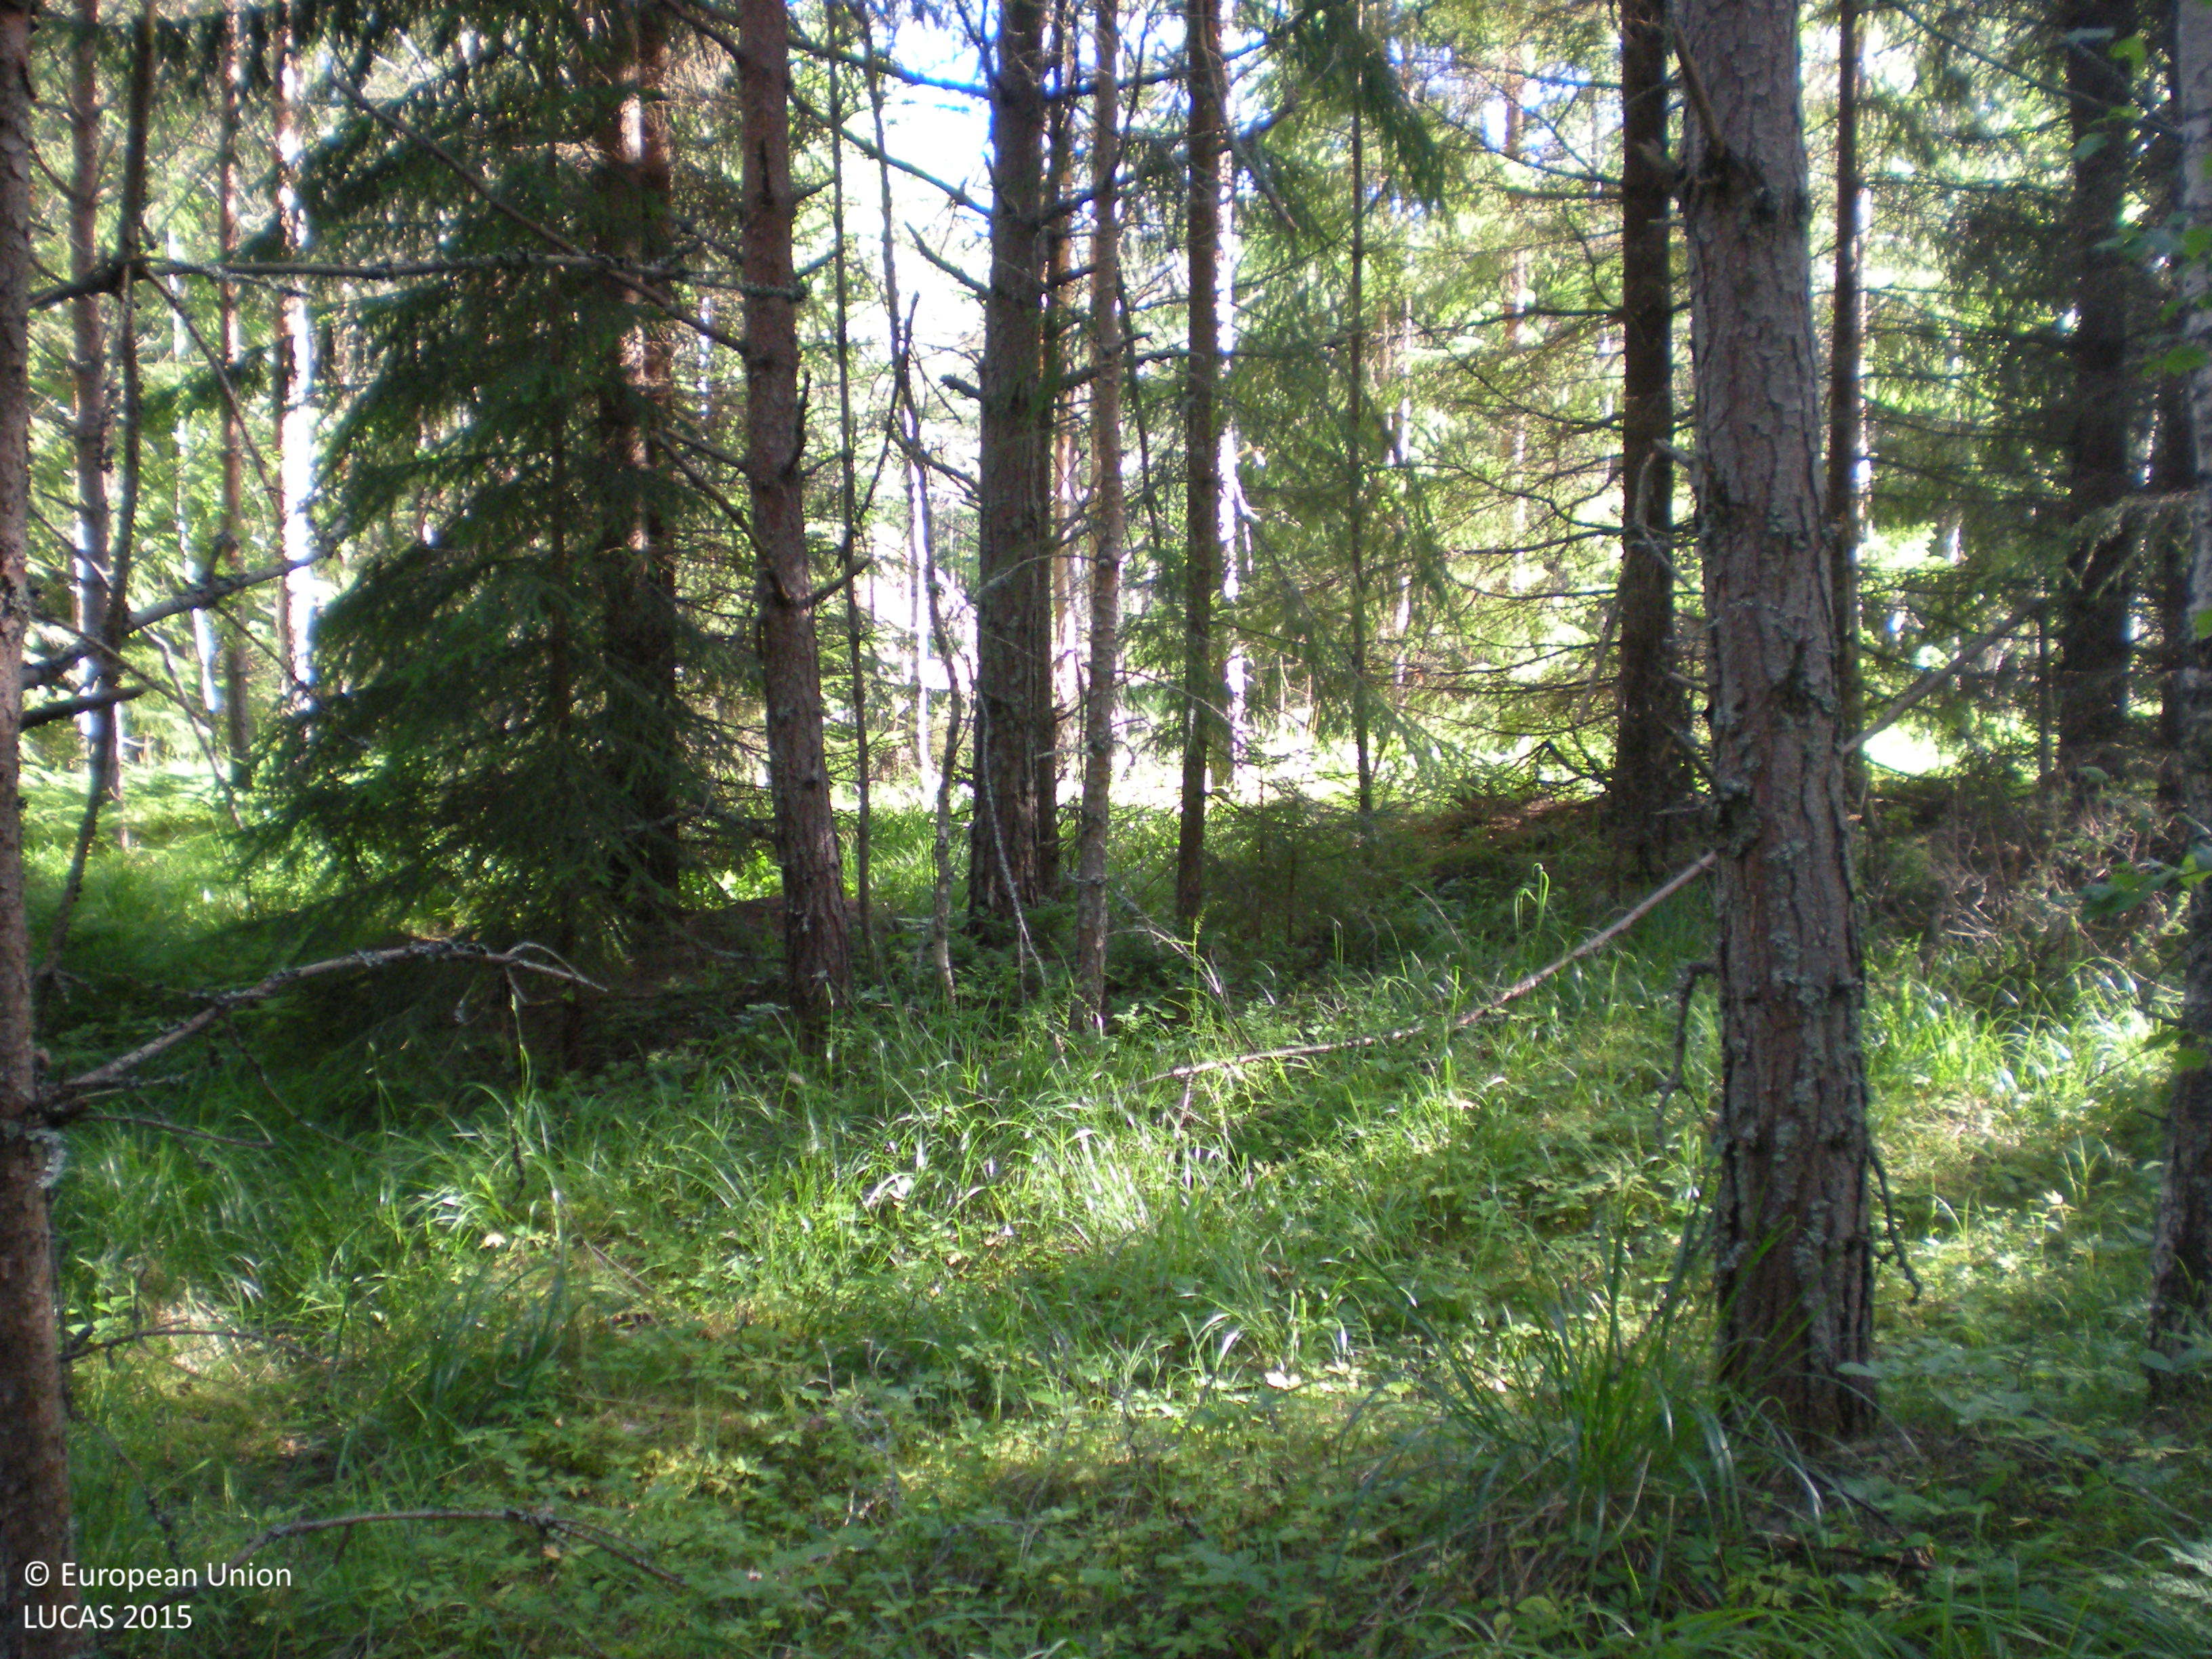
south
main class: Woodland
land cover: Other coniferous woodland
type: boreal forest
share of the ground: 50 - 75 %
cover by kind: coniferous forest trees 70 %, broadleaved forest trees 10 %, herbaceous plants 10 %, shrubs 5 %, lichens and mosses 5 %
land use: Forestry
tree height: > 5 m
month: June
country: SE
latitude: 60.3525
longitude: 17.9858
